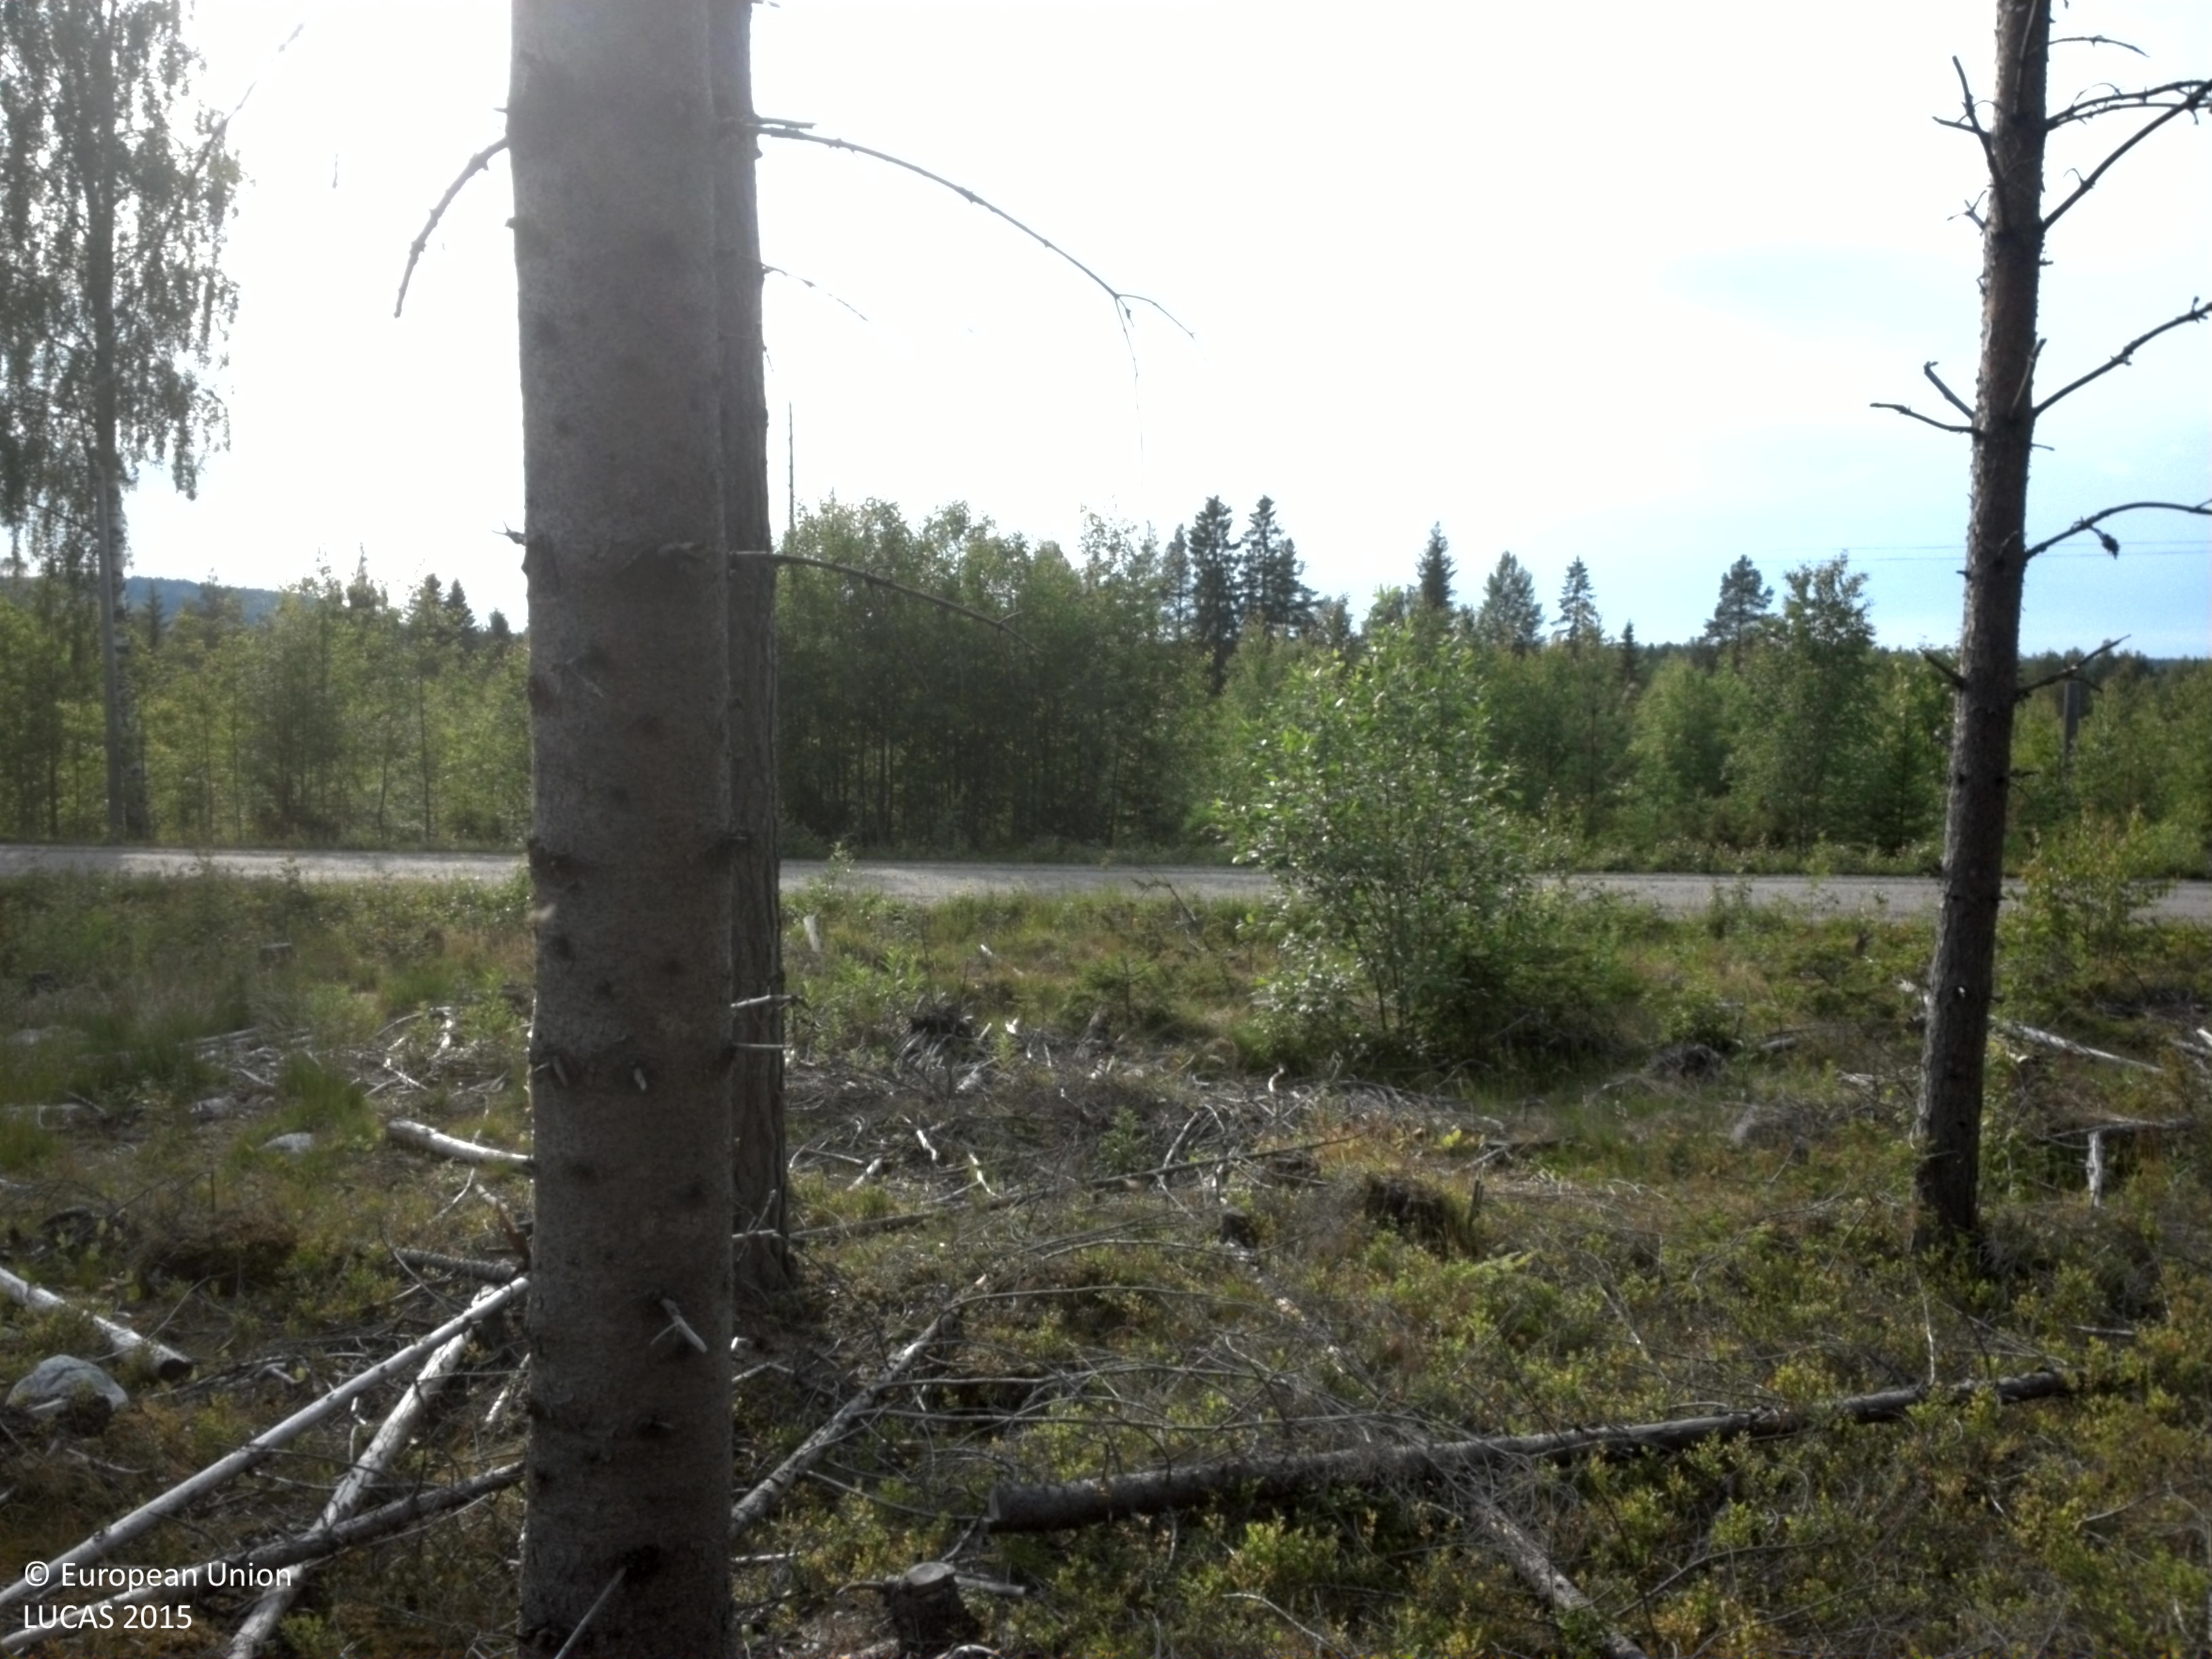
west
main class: Woodland
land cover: Pine dominated coniferous woodland
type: boreal forest
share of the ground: 50 - 75 %
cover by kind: coniferous forest trees 75 %, shrubs 20 %, herbaceous plants 5 %
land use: Forestry
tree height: > 5 m
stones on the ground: > 50 %
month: July
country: SE
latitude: 64.4662
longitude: 20.8128
